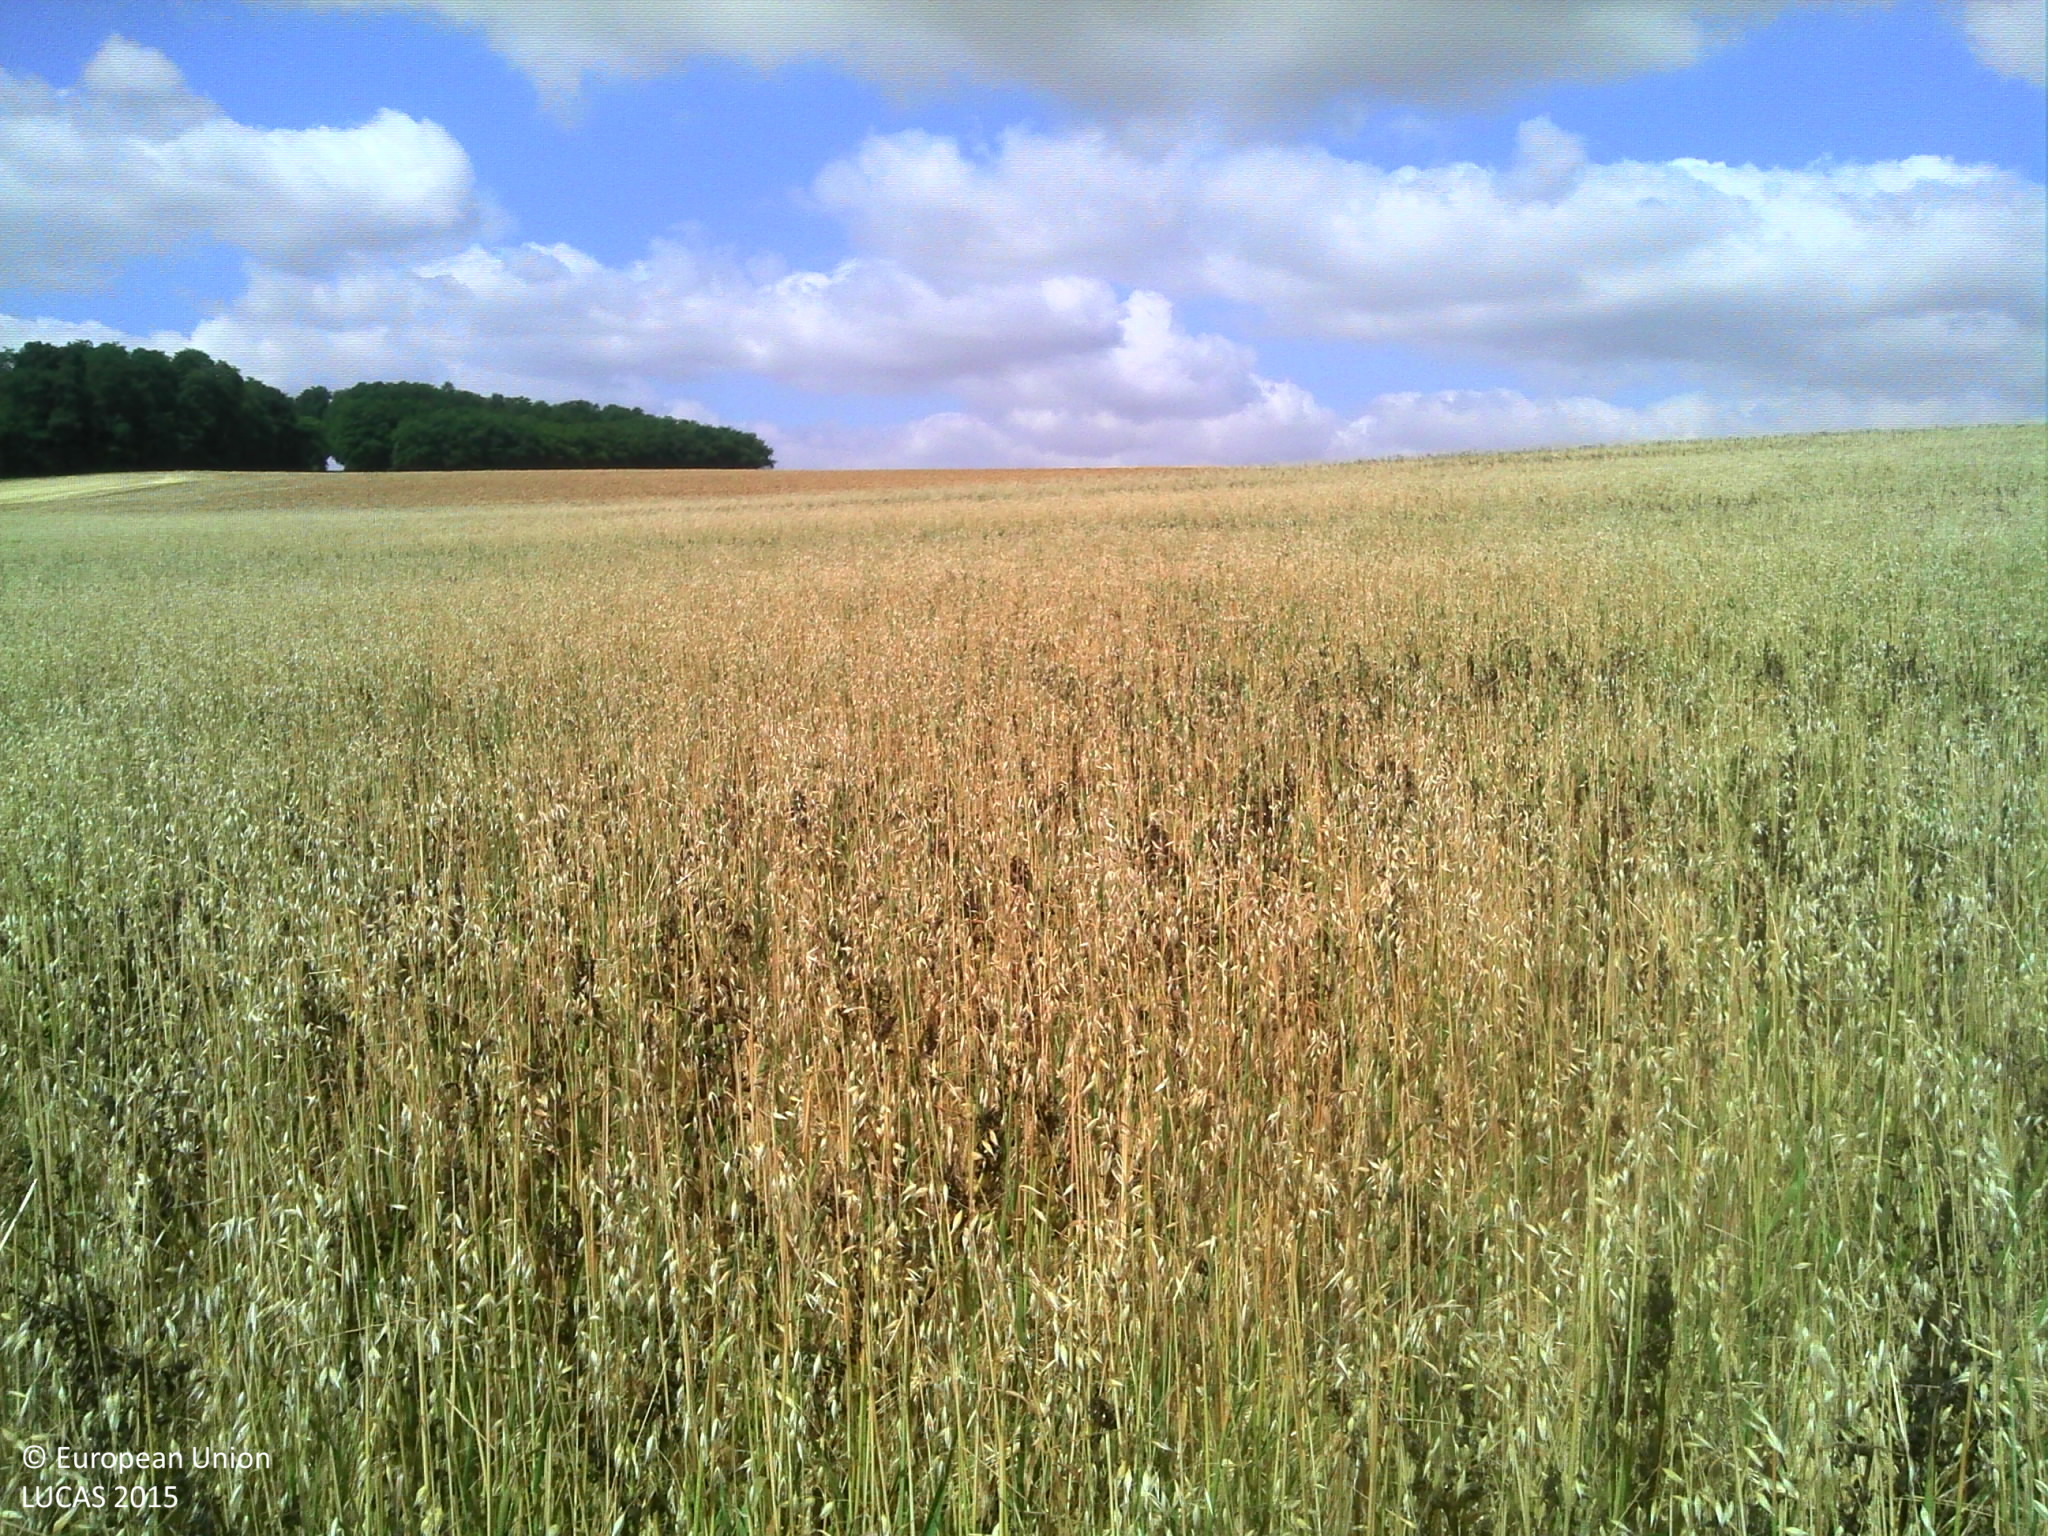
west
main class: Cropland
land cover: Mixed cereals for fodder
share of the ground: > 75 %
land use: Agriculture (excluding fallow land and kitchen gardens)
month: July
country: FR
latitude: 48.3309
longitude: 3.3707
